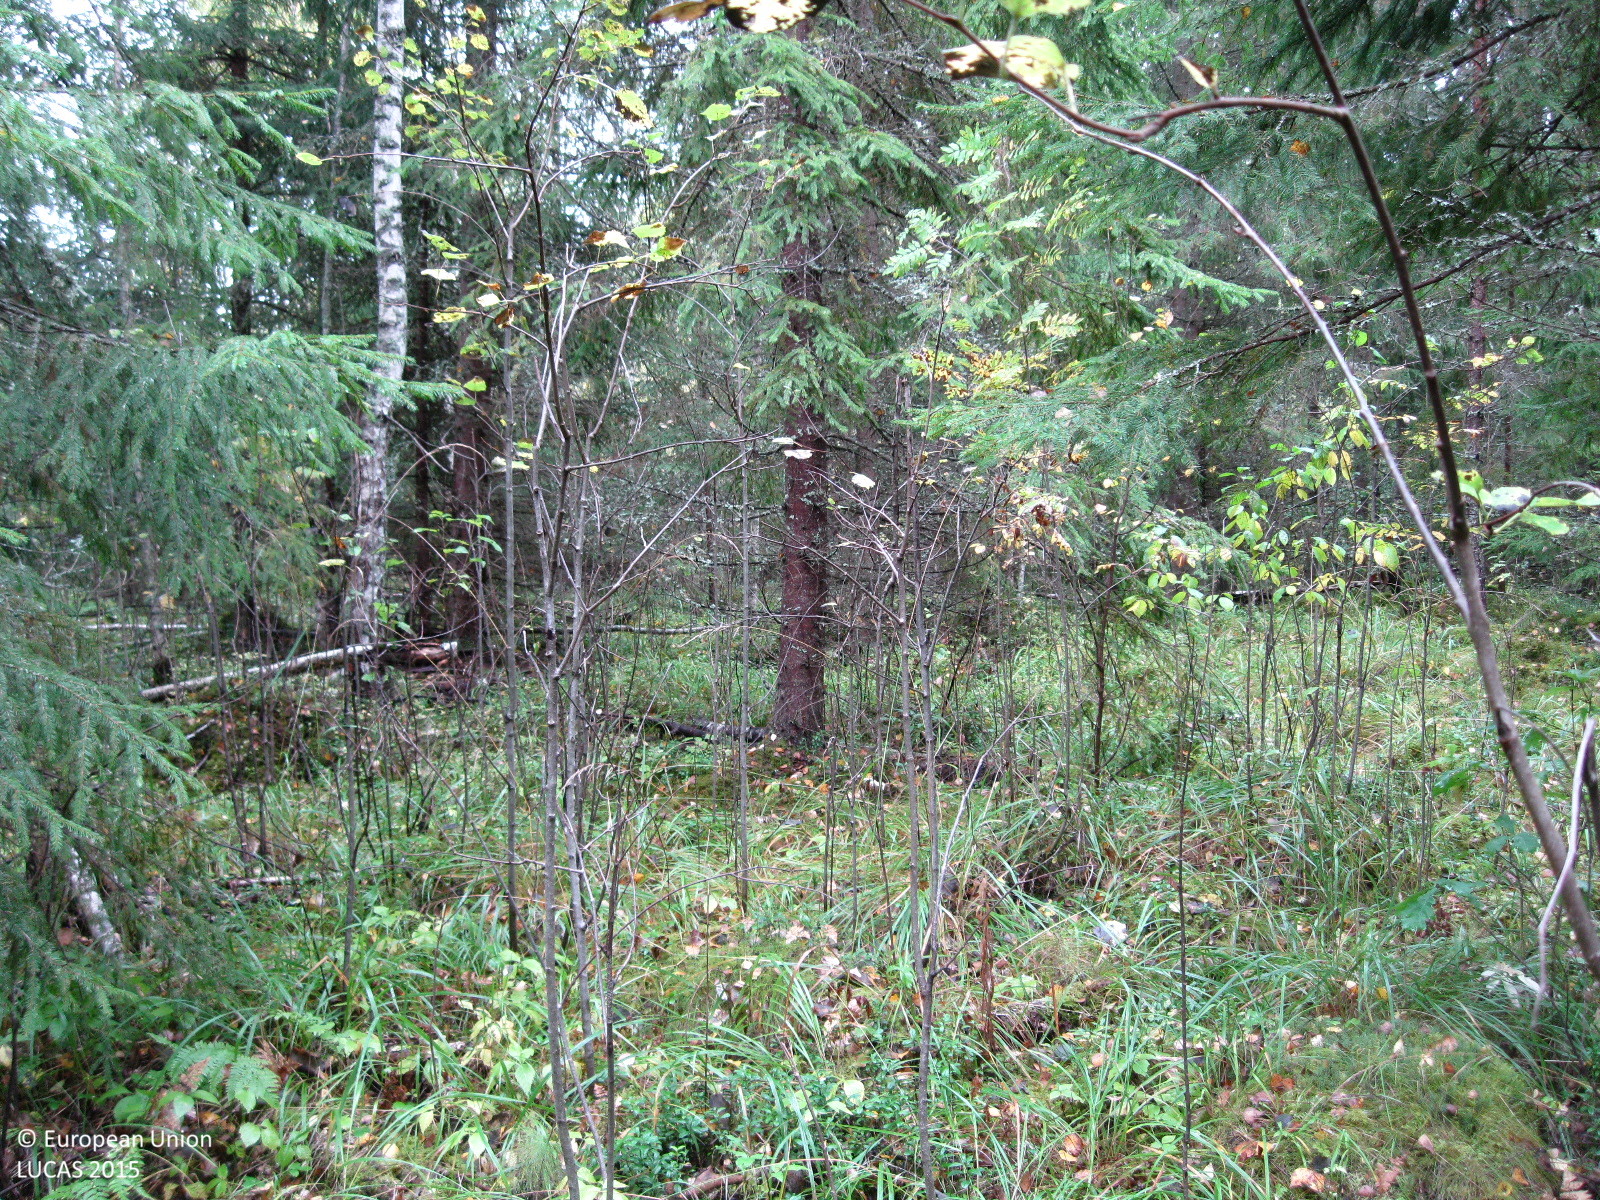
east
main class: Woodland
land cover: Spruce dominated mixed woodland
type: boreal forest
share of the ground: 50 - 75 %
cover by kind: coniferous forest trees 50 %, broadleaved forest trees 20 %, herbaceous plants 20 %, shrubs 5 %, lichens and mosses 5 %
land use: Forestry
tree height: > 5 m
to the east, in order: Spruce dominated mixed woodland; Ditches and canals; Grass margins; Temporary grasslands
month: September
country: FI
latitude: 60.8612
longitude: 24.8207
